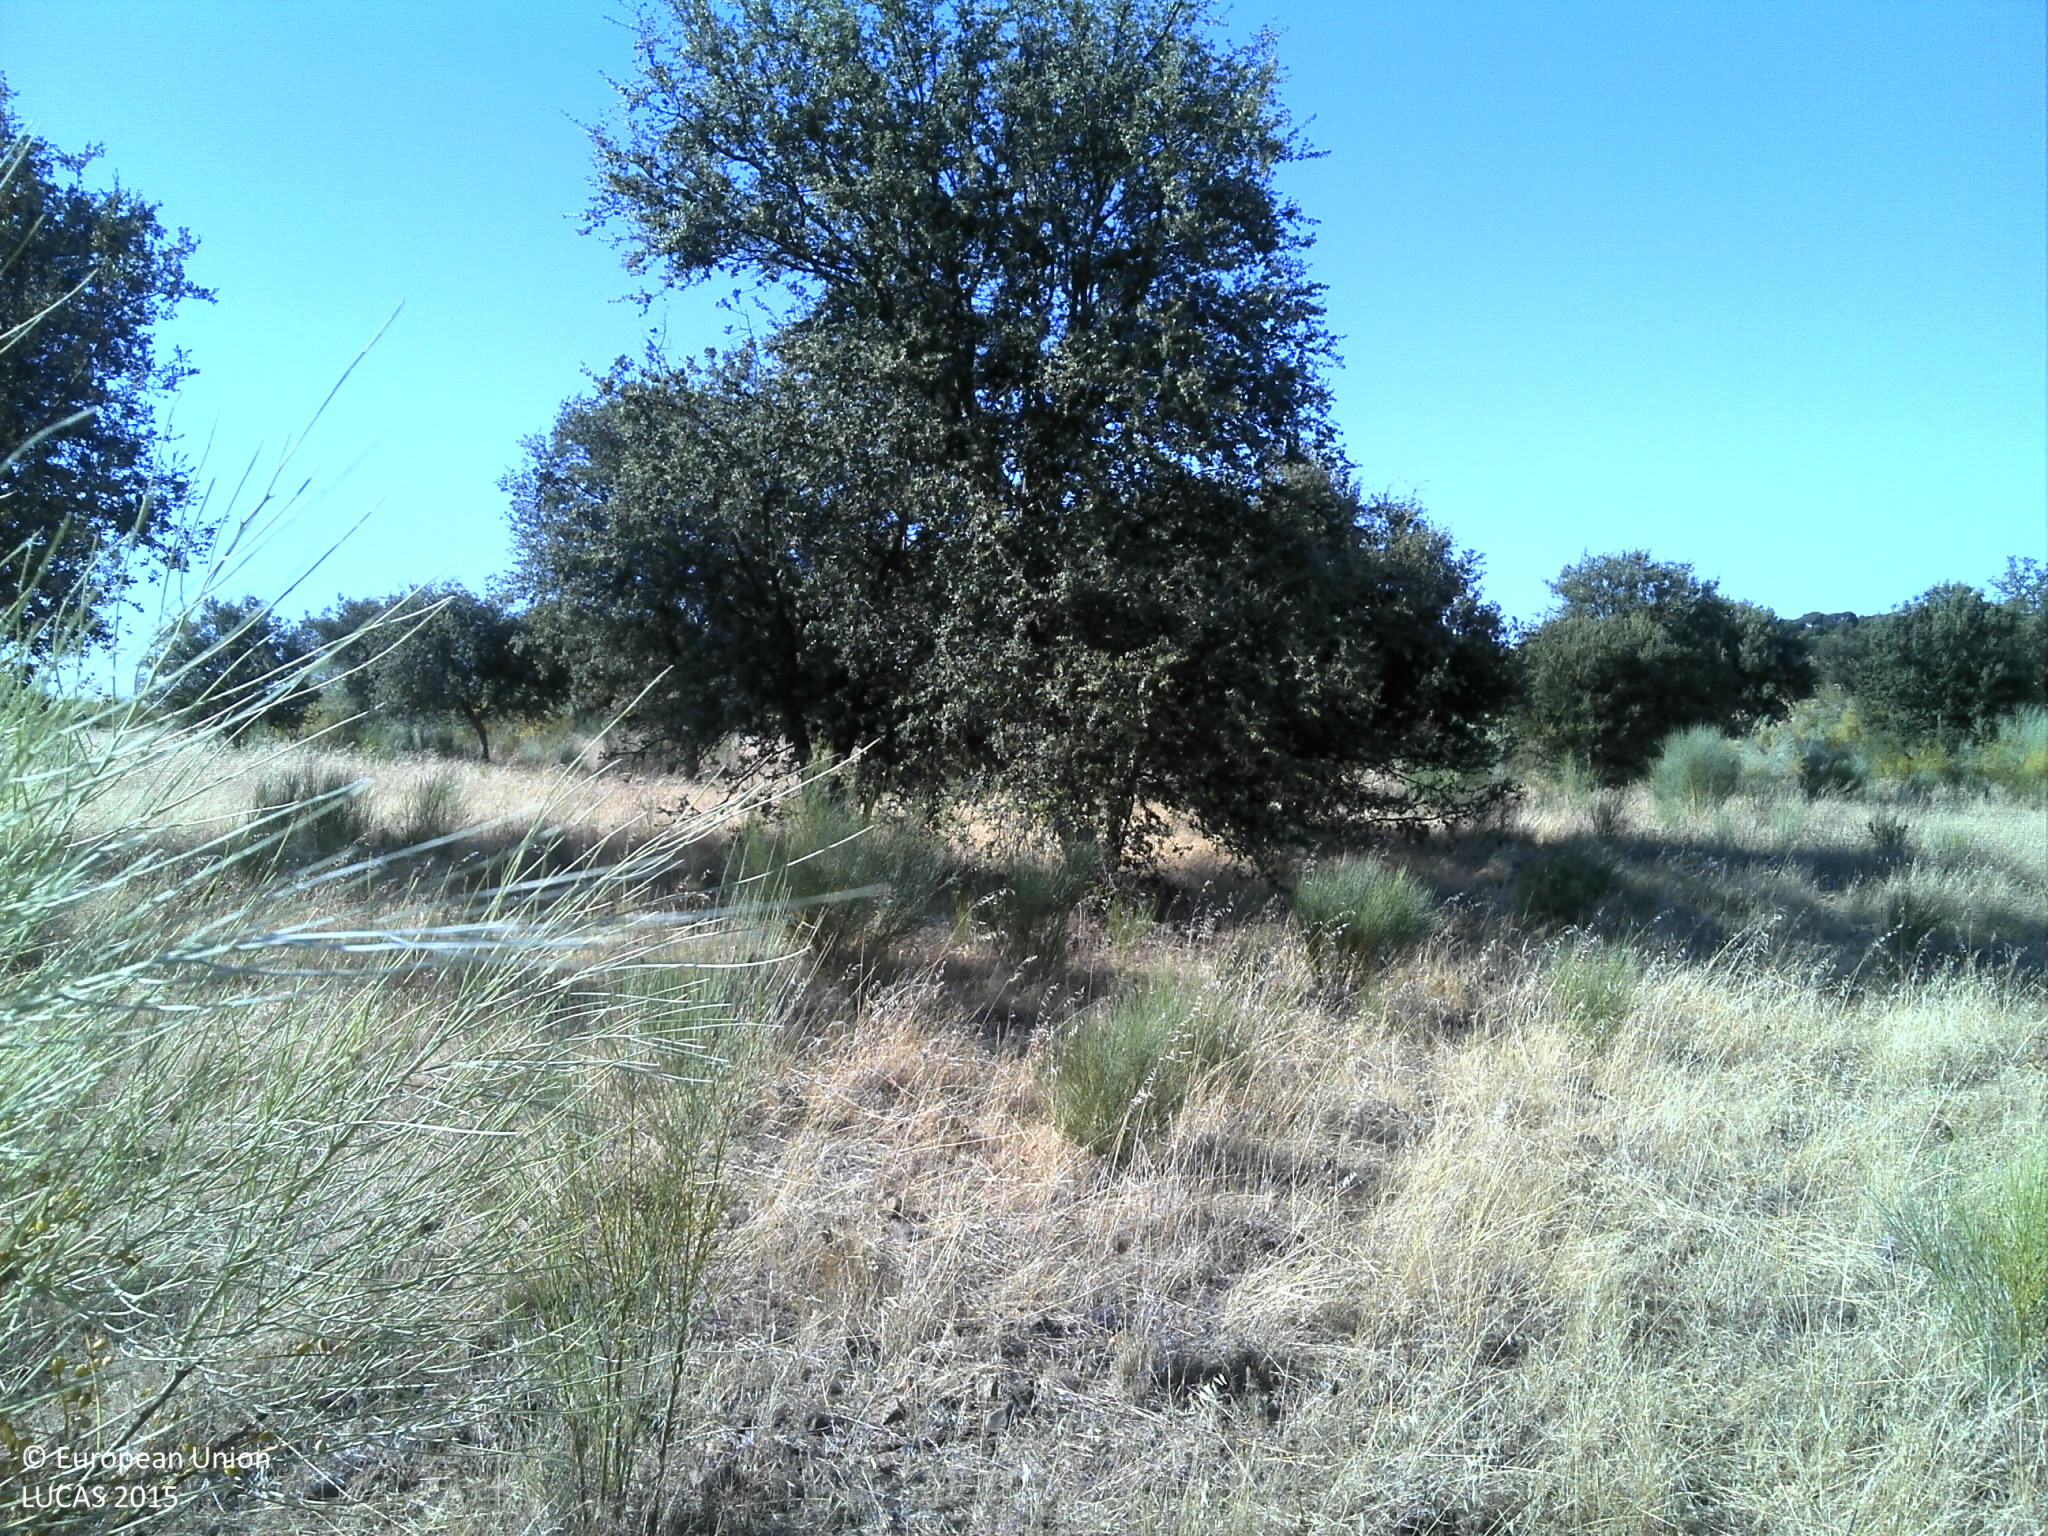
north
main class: Shrubland
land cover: Shrubland with sparse tree cover
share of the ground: 25 - 50 %
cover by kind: unconsolidated bare surface 70 %, shrubs 15 %, herbaceous plants 10 %, broadleaved forest trees 5 %
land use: Agriculture (excluding fallow land and kitchen gardens)
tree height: < 5 m
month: July
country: PT
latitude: 38.9664
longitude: -7.4518
